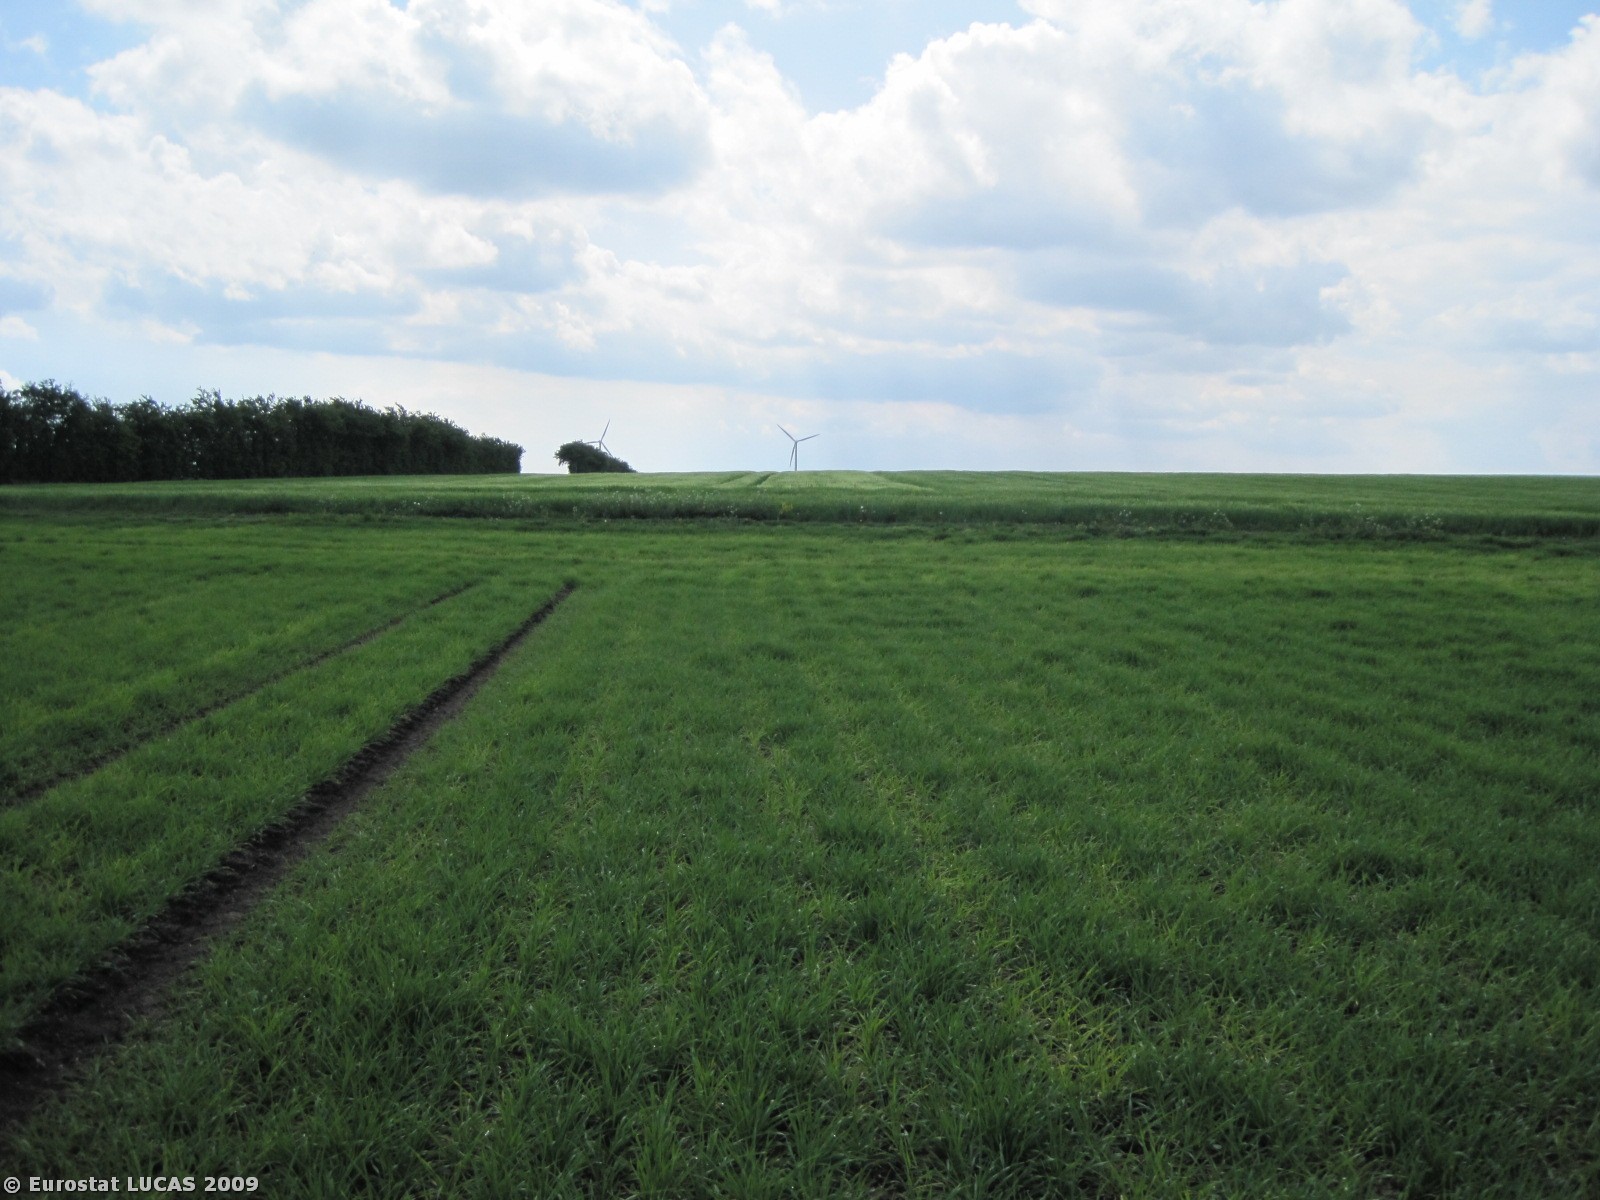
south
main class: Cropland
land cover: Barley
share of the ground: > 75 %
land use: Agriculture (excluding fallow land and kitchen gardens)
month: May
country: DK
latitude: 56.3492
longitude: 9.6929
